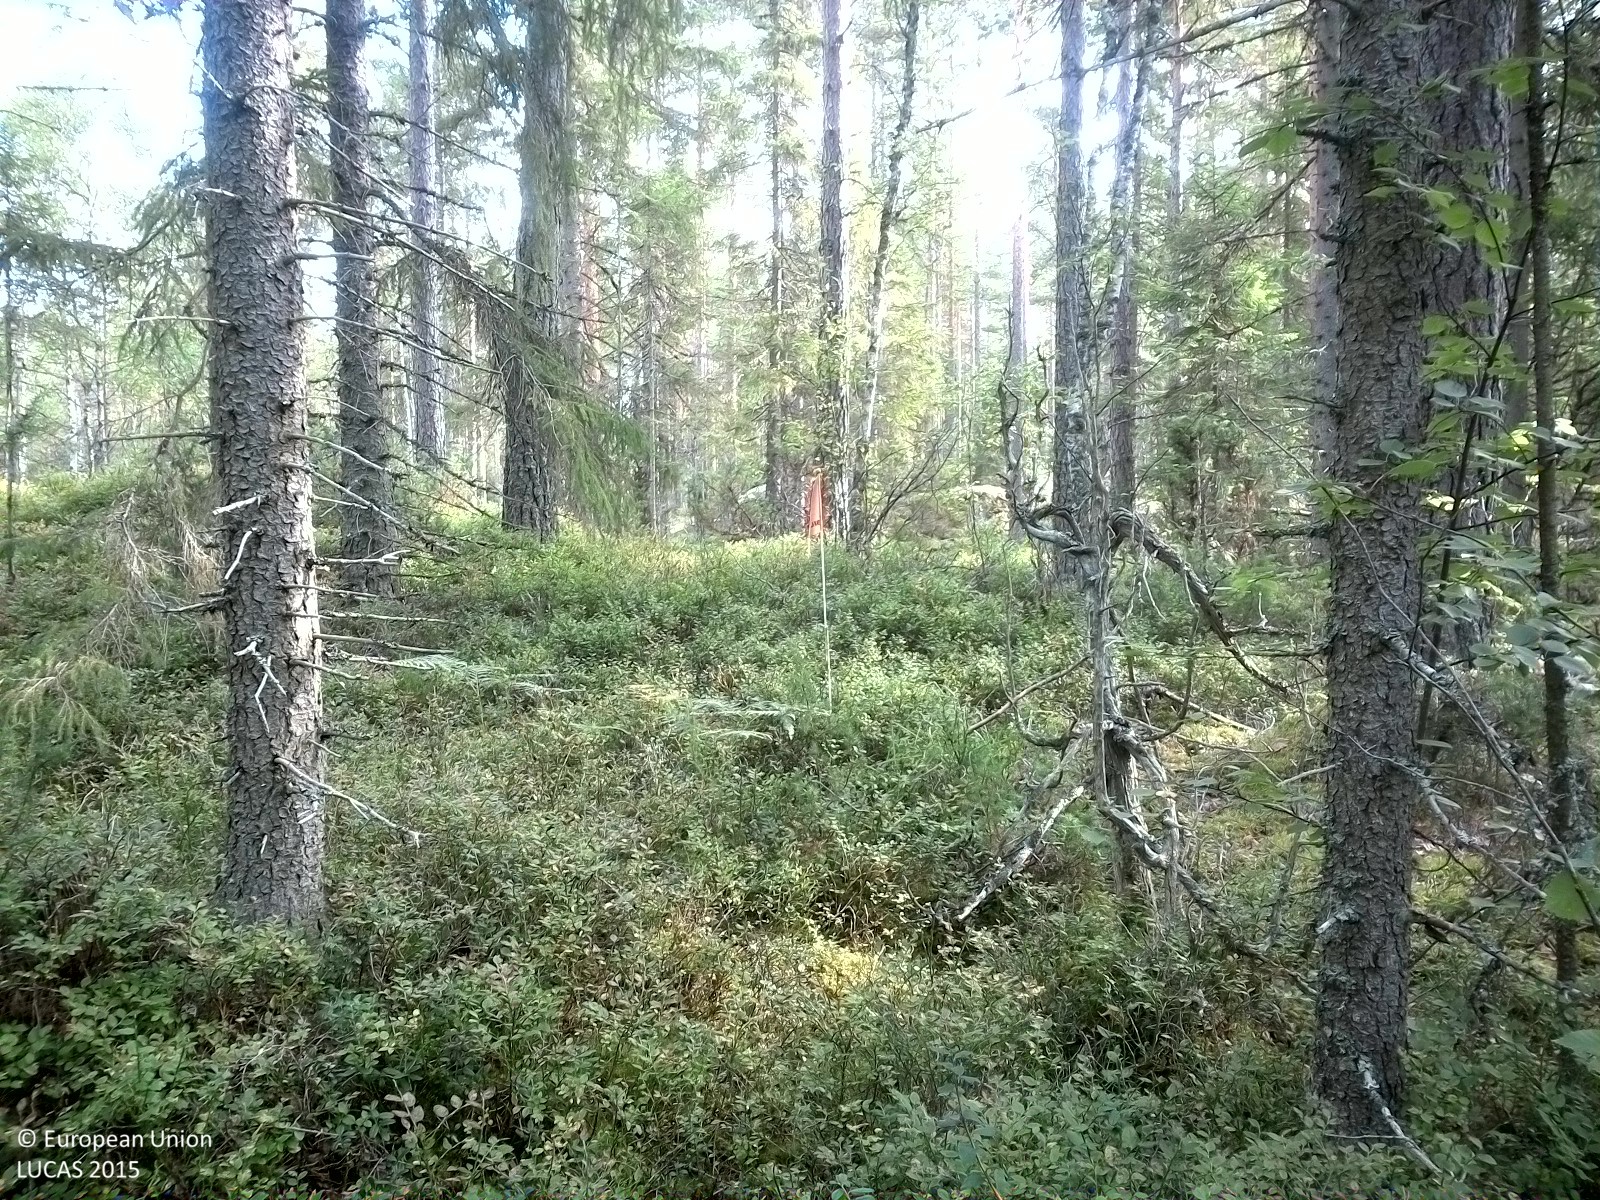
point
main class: Woodland
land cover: Pine dominated coniferous woodland
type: boreal forest
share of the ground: 25 - 50 %
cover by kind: coniferous forest trees 35 %, herbaceous plants 35 %, lichens and mosses 20 %, broadleaved forest trees 5 %, shrubs 5 %
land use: Forestry
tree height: > 5 m
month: August
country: SE
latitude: 58.8098
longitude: 15.5158
